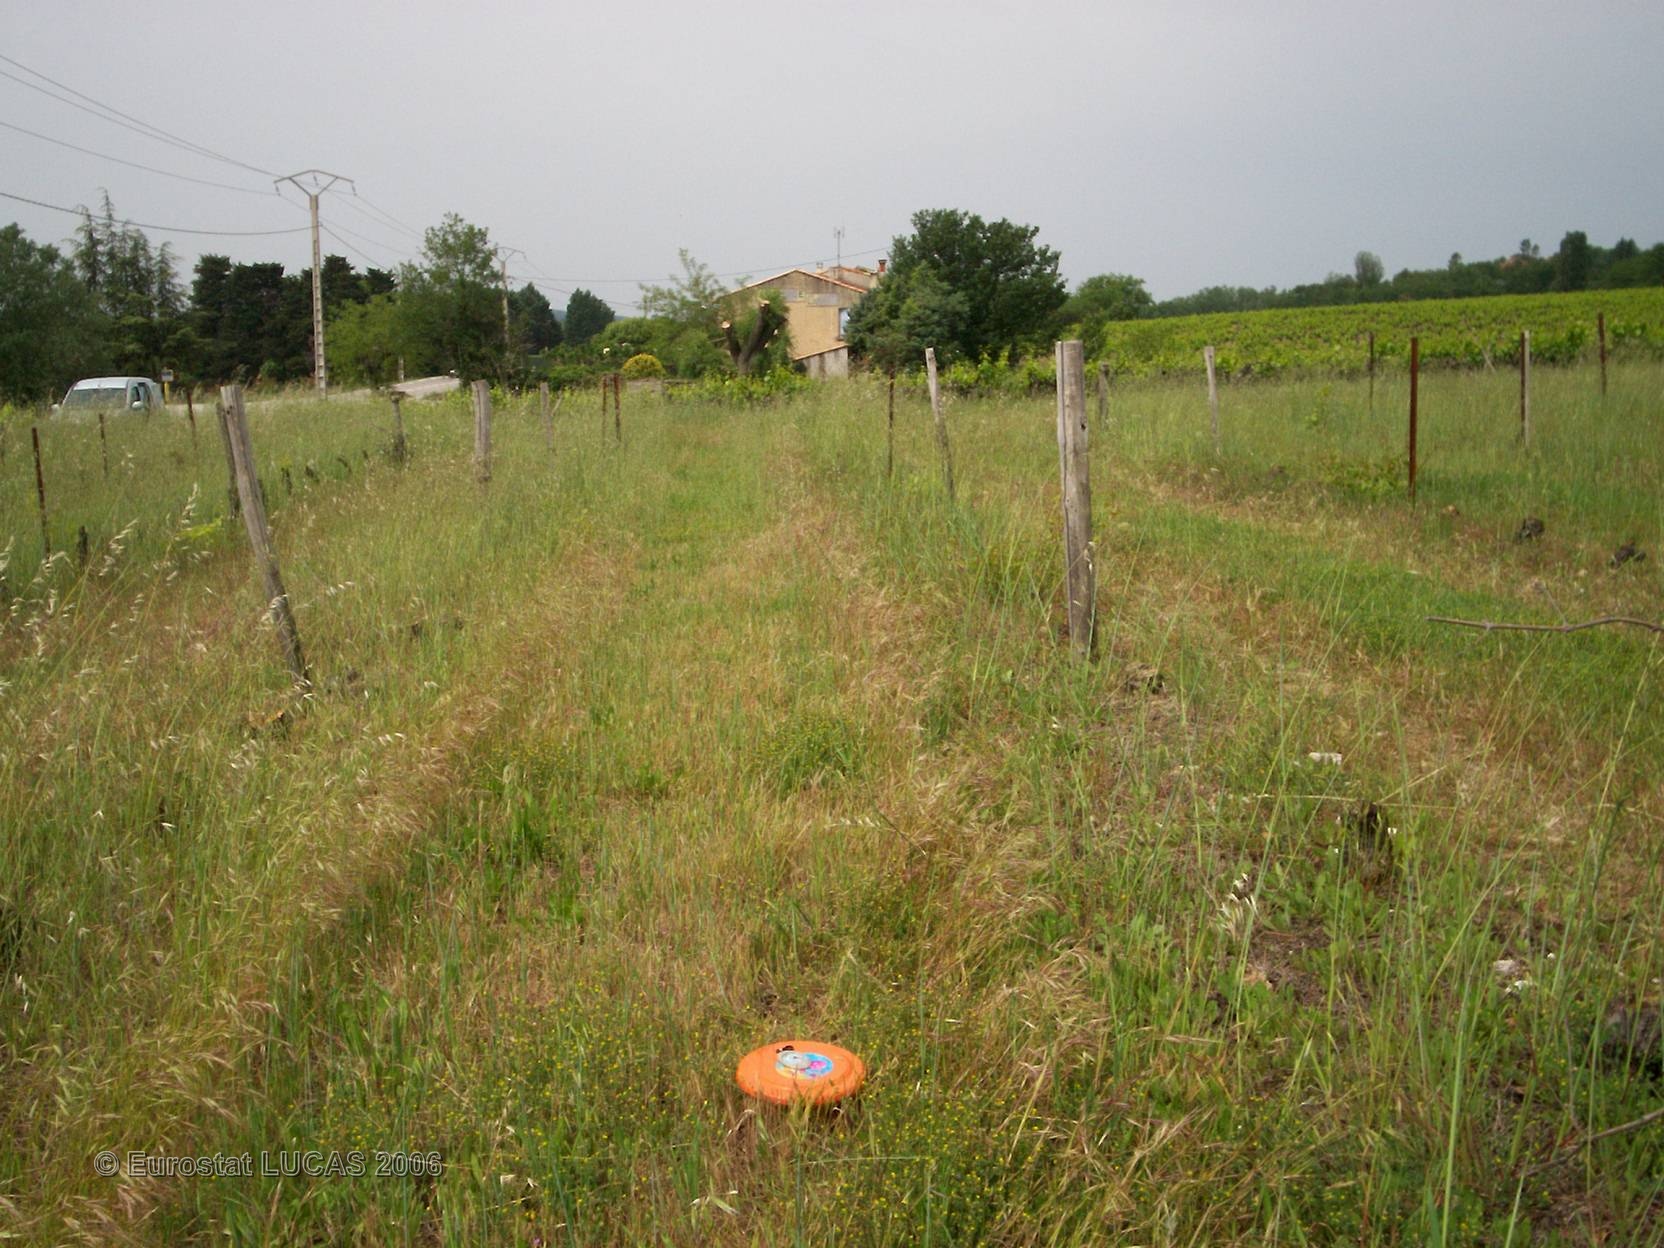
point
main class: Cropland
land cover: Vineyards
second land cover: Grassland with sparse tree/shrub cover
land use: Agriculture (excluding fallow land and kitchen gardens)
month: May
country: FR
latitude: 44.4212
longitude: 4.8450
